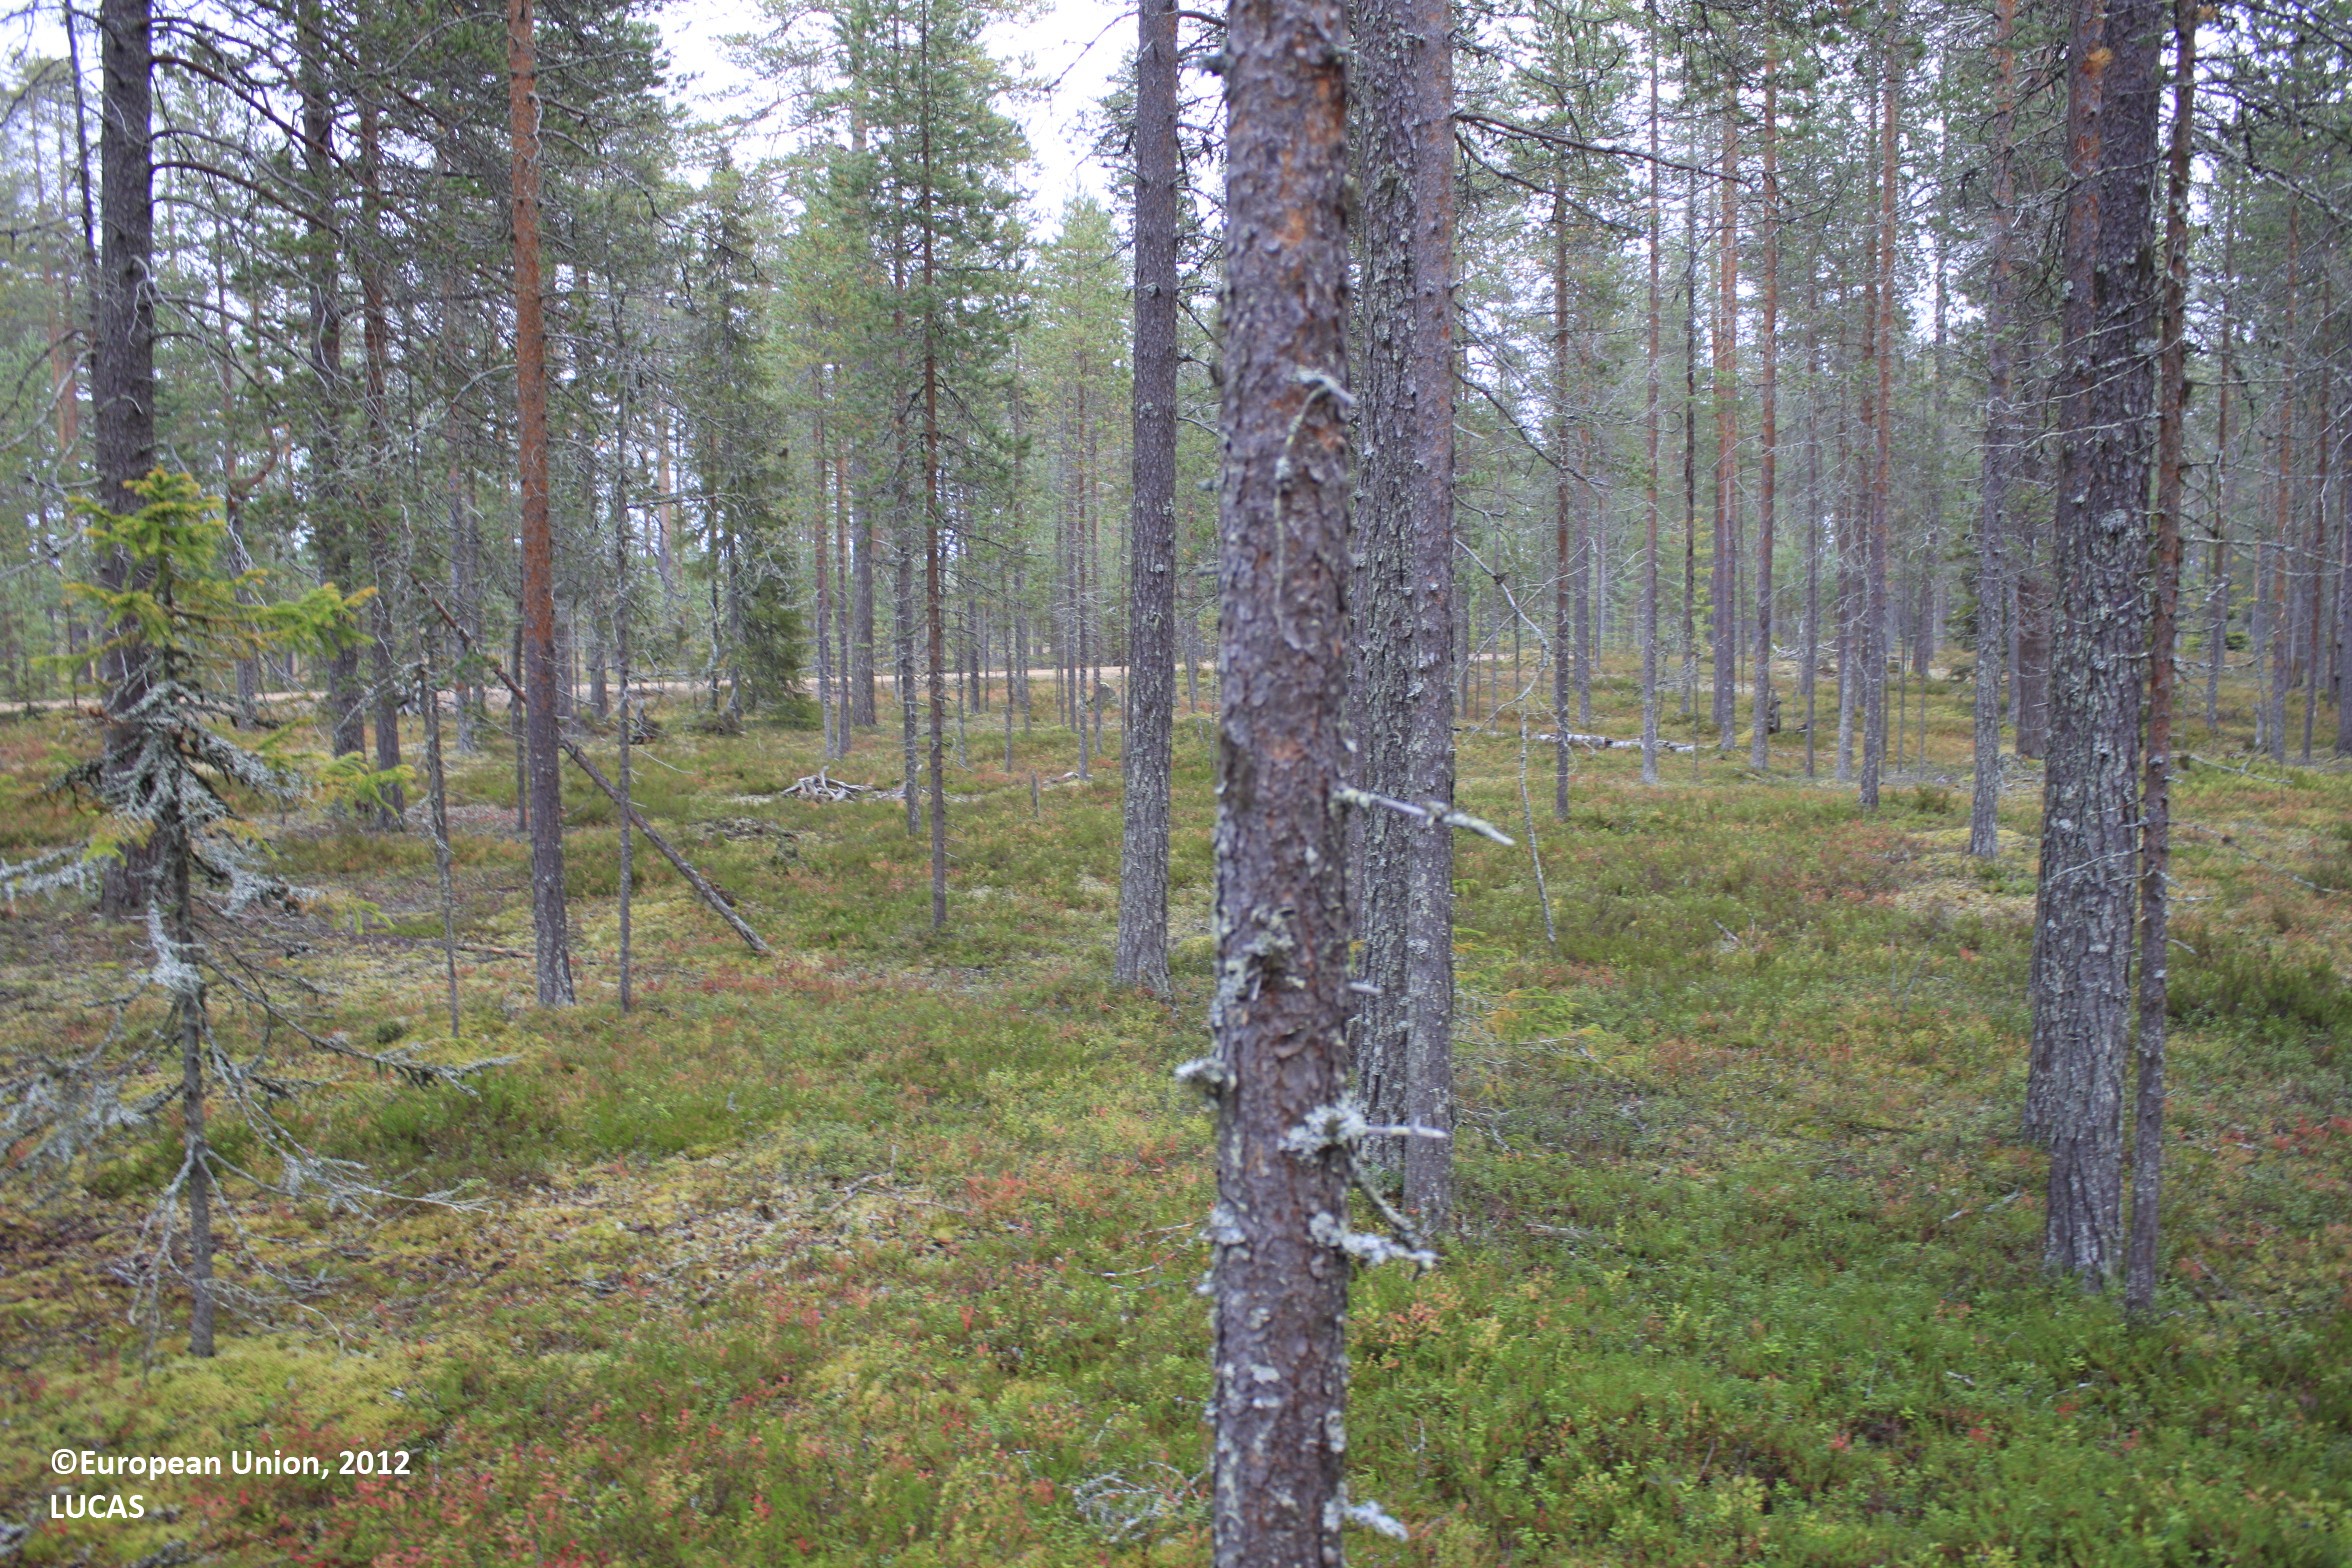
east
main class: Woodland
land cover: Pine dominated coniferous woodland
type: boreal forest
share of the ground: 50 - 75 %
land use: Forestry
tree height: > 5 m
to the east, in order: Pine dominated coniferous woodland; Ditches and canals; Pine dominated coniferous woodland; Tracks; Pine dominated coniferous woodland; Ditches and canals; Pine dominated coniferous woodland
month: September
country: FI
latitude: 65.5409
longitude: 27.1087
